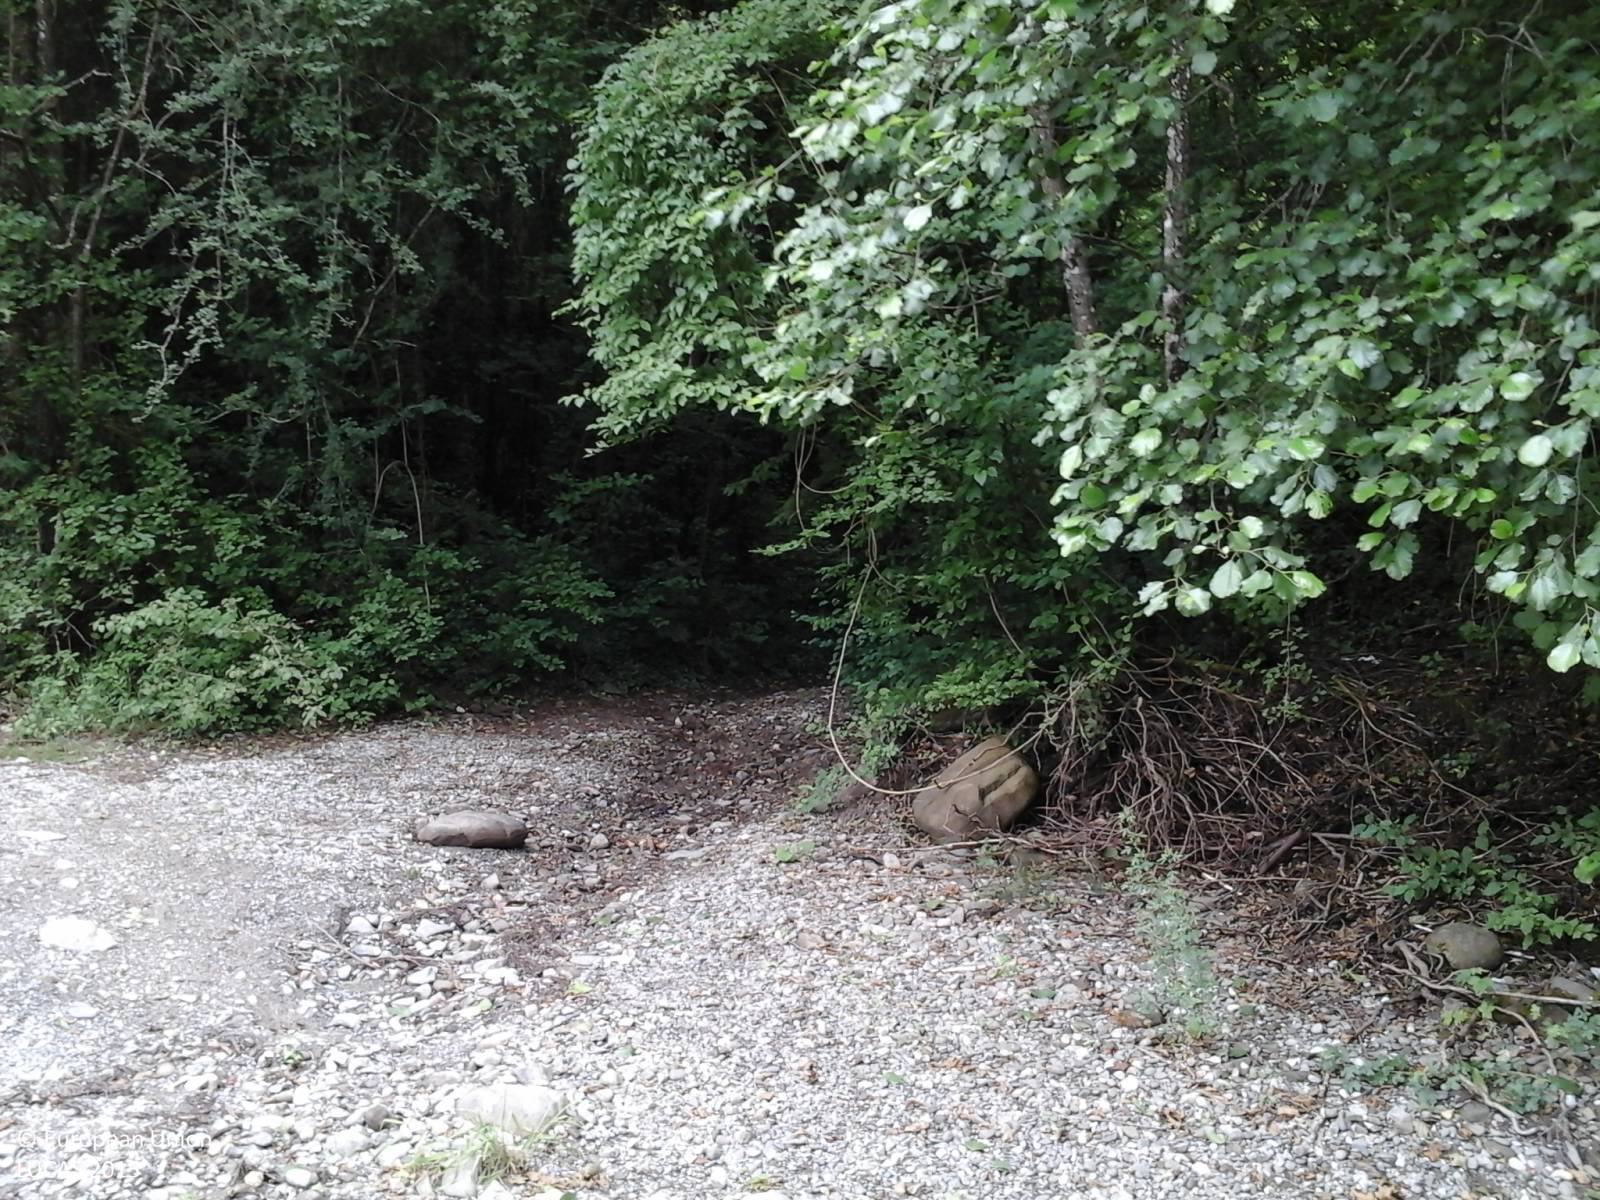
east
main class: Woodland
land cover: Broadleaved woodland
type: thermophilous deciduous forest
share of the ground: > 75 %
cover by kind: broadleaved forest trees 70 %, shrubs 30 %
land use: Forestry
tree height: > 5 m
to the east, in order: Broadleaved woodland; Electric lines; Broadleaved woodland; Rivers and streams; Broadleaved woodland; Rivers and streams; Broadleaved woodland
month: June
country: IT
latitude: 44.0415
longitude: 10.7096
